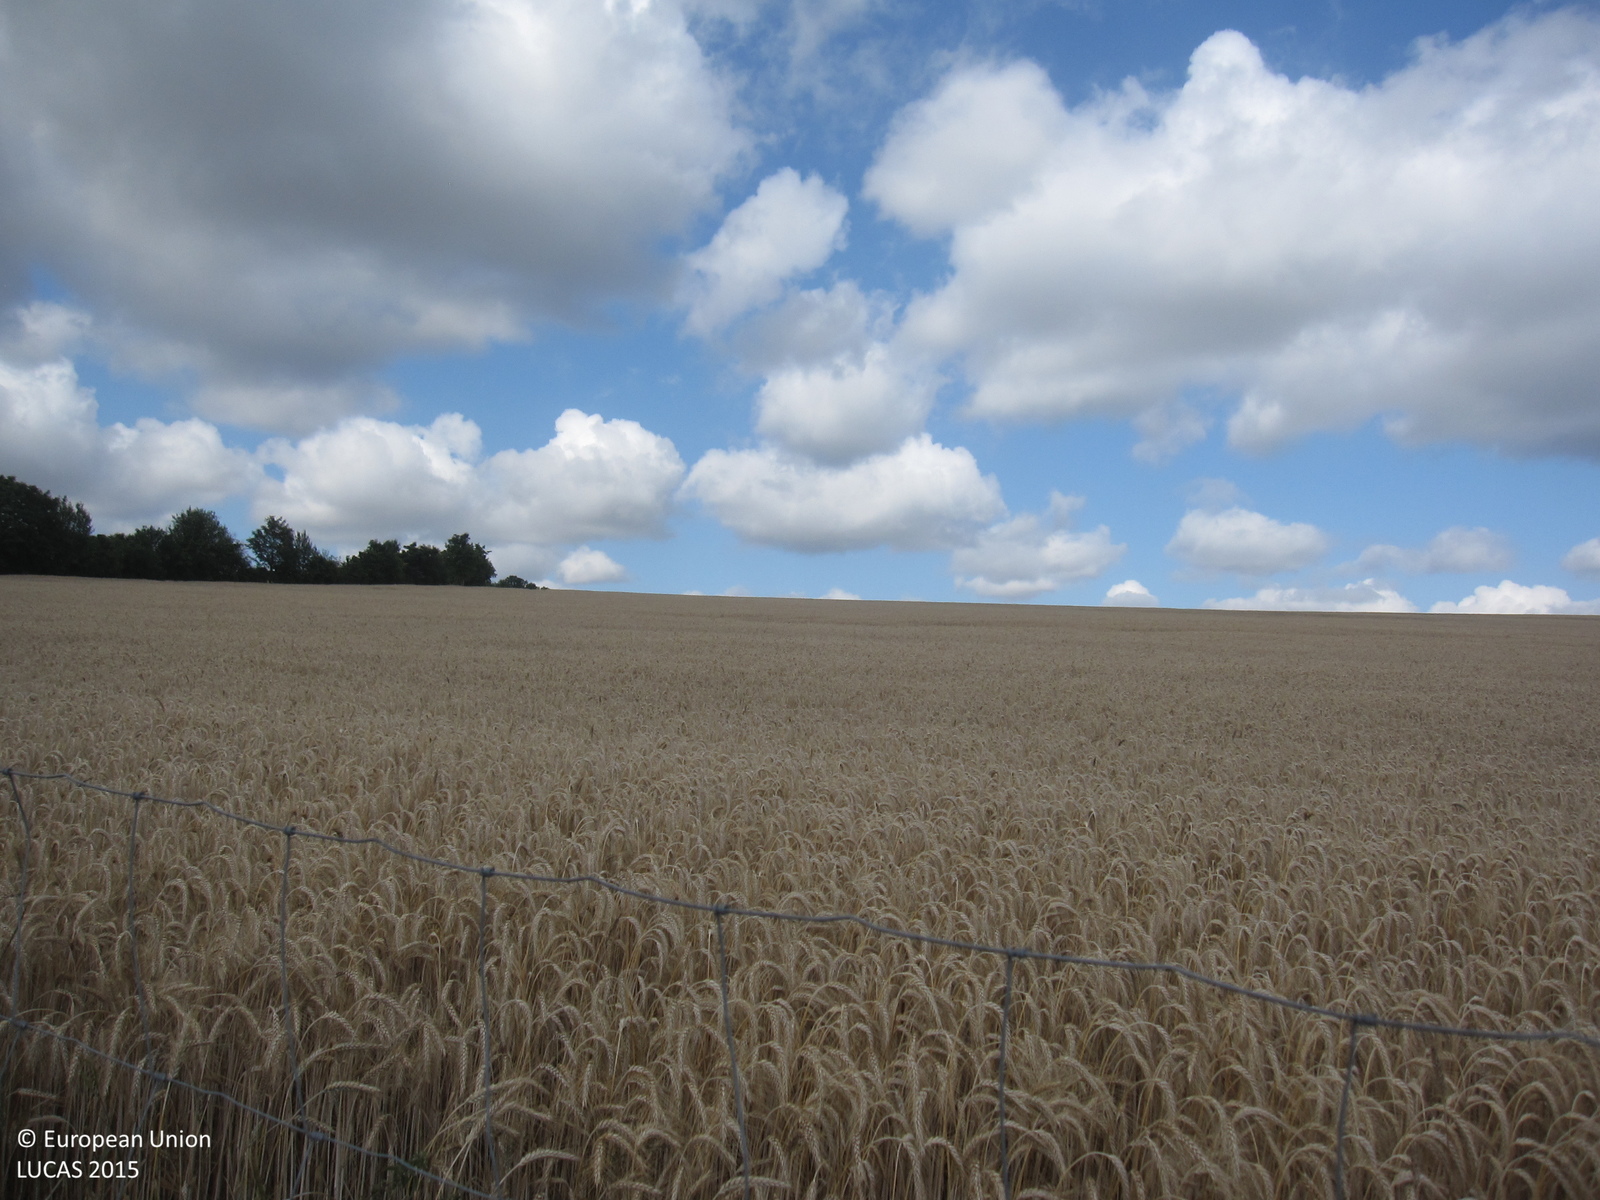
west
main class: Cropland
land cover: Rye
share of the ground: > 75 %
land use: Agriculture (excluding fallow land and kitchen gardens)
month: July
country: DE
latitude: 50.3819
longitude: 12.0388
